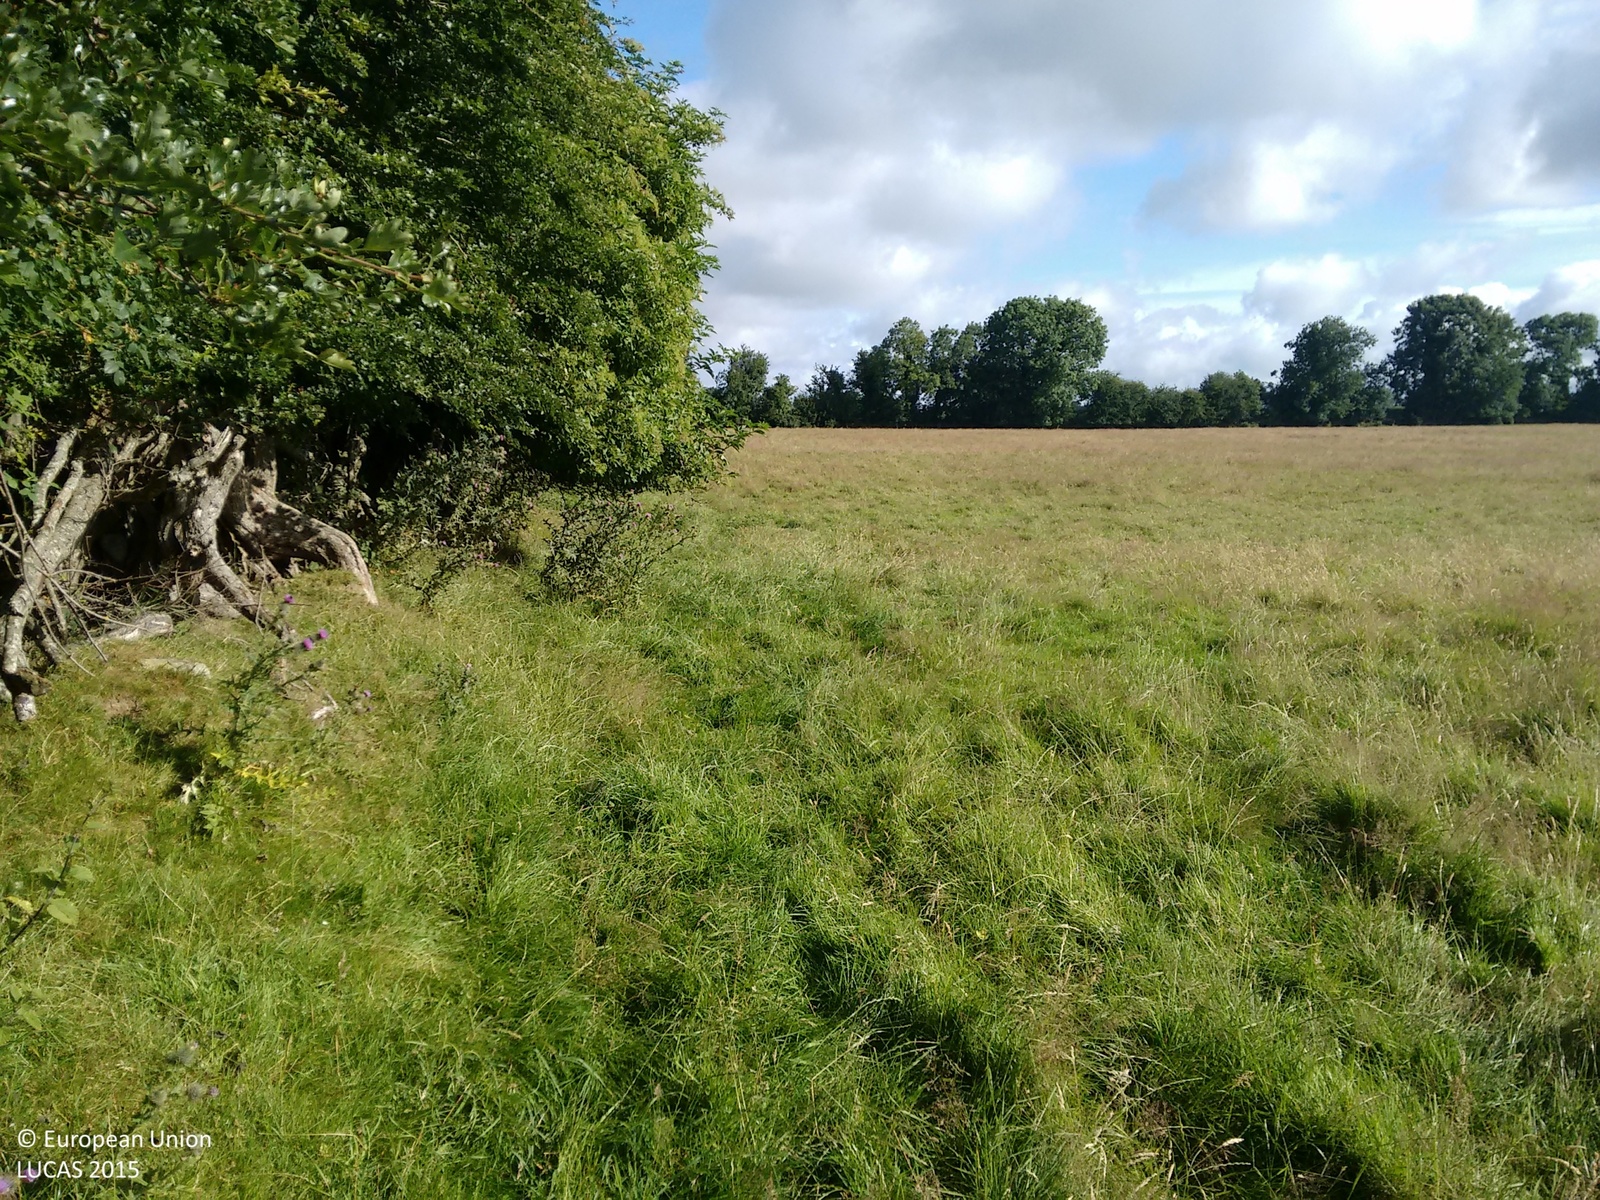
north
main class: Grassland
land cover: Grassland without tree/shrub cover
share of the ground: > 75 %
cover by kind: herbaceous plants 100 %
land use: Agriculture (excluding fallow land and kitchen gardens)
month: July
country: IE
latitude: 52.8132
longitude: -6.7367
